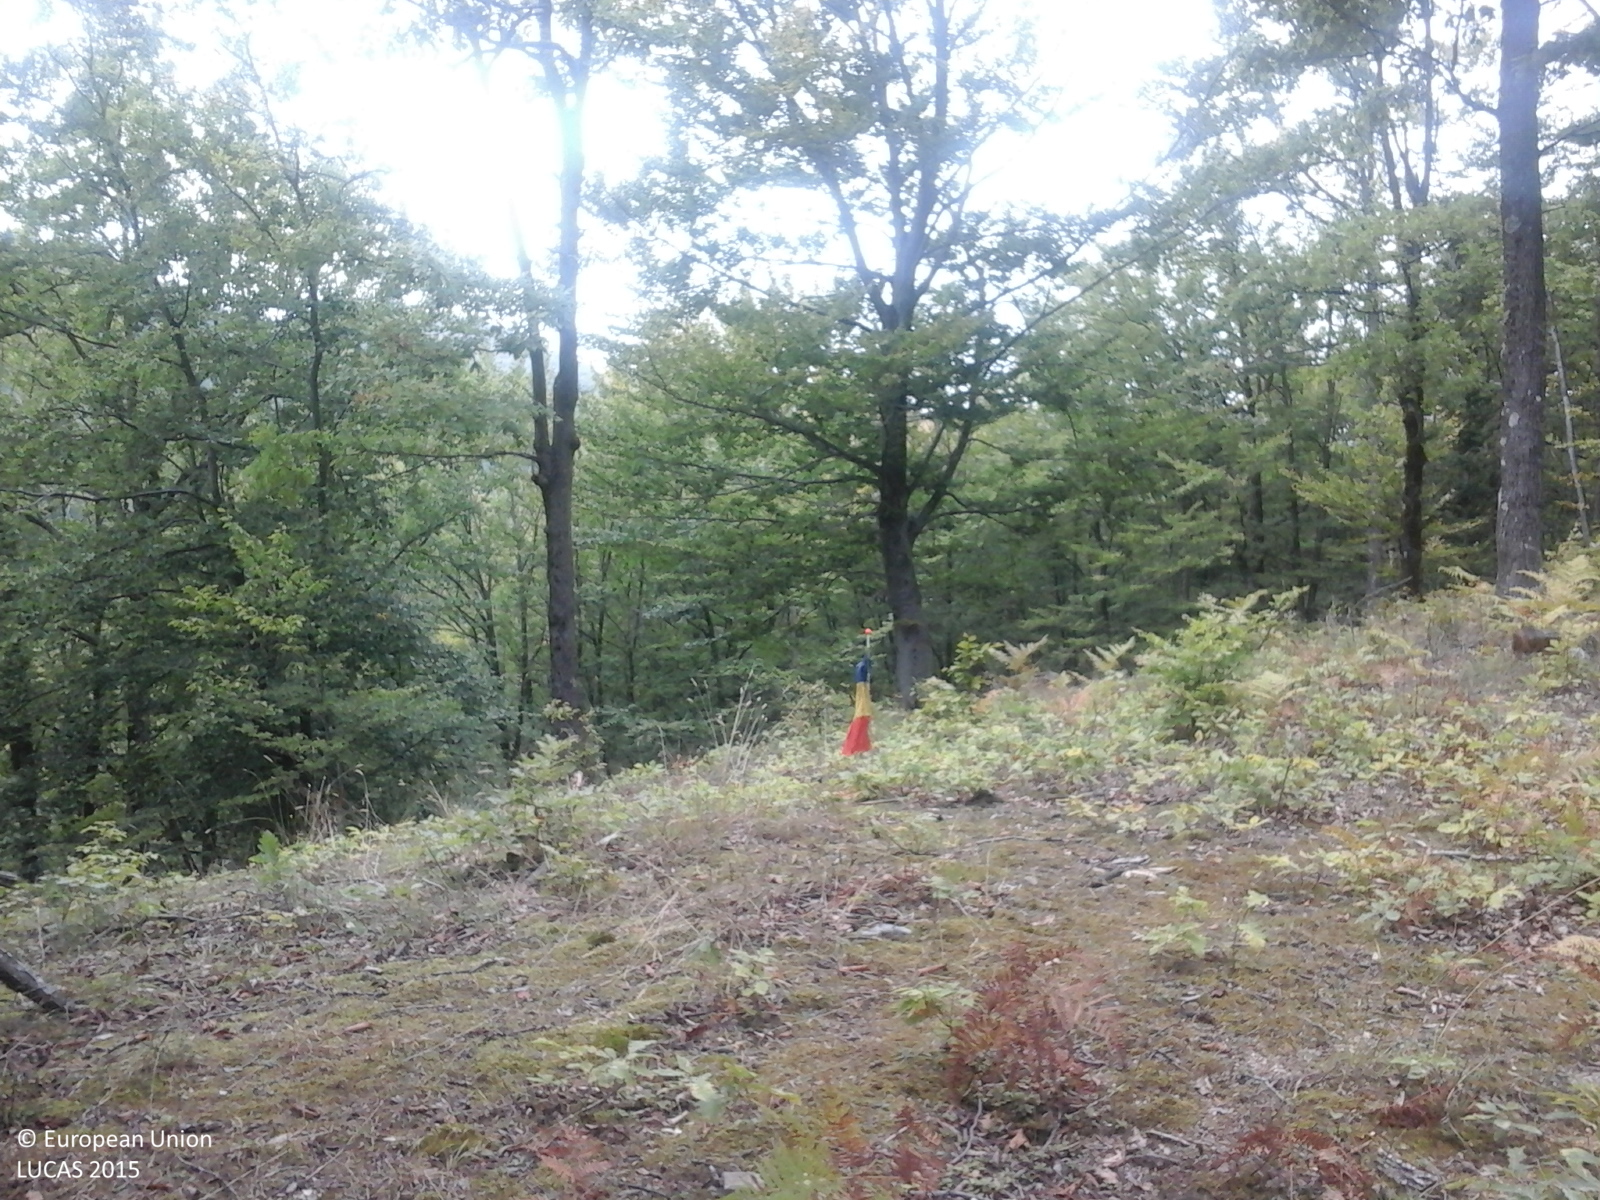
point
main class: Woodland
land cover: Broadleaved woodland
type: beech forest
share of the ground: > 75 %
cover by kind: broadleaved forest trees 100 %
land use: Forestry
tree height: > 5 m
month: September
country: RO
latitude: 45.0459
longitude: 22.8320
